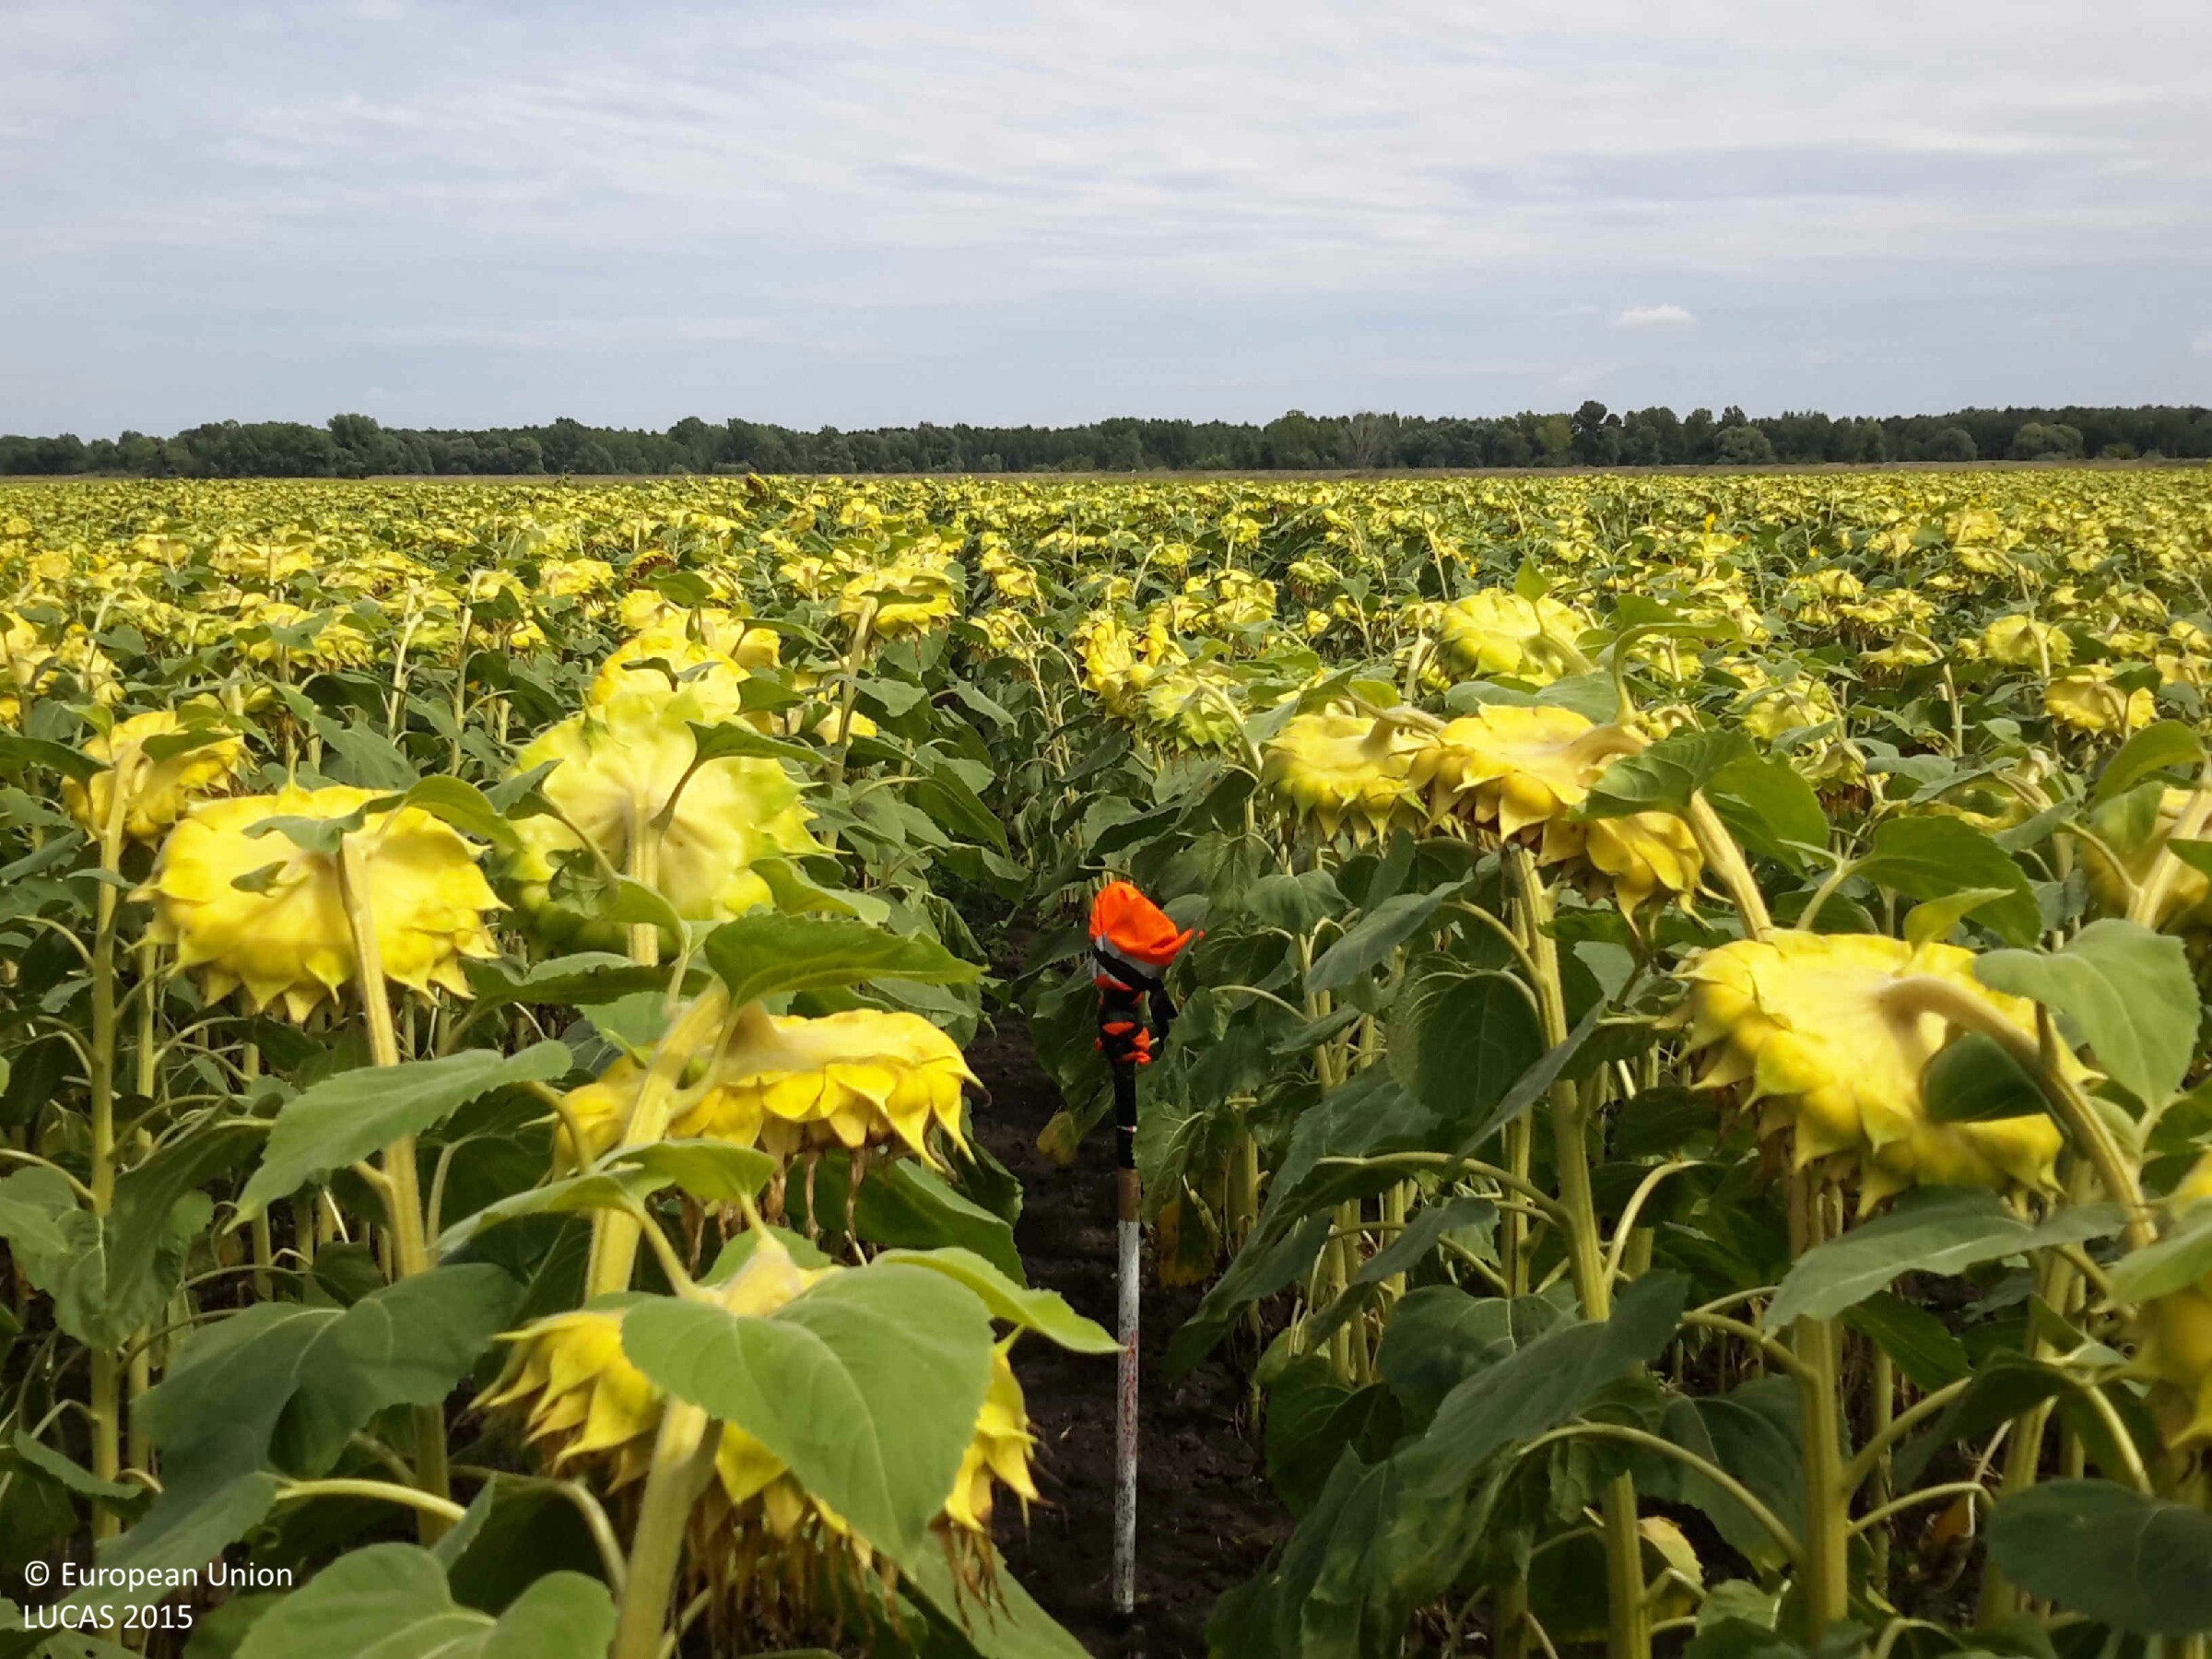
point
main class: Cropland
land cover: Sunflower
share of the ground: > 75 %
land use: Agriculture (excluding fallow land and kitchen gardens)
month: July
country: HU
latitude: 47.5887
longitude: 17.4948
